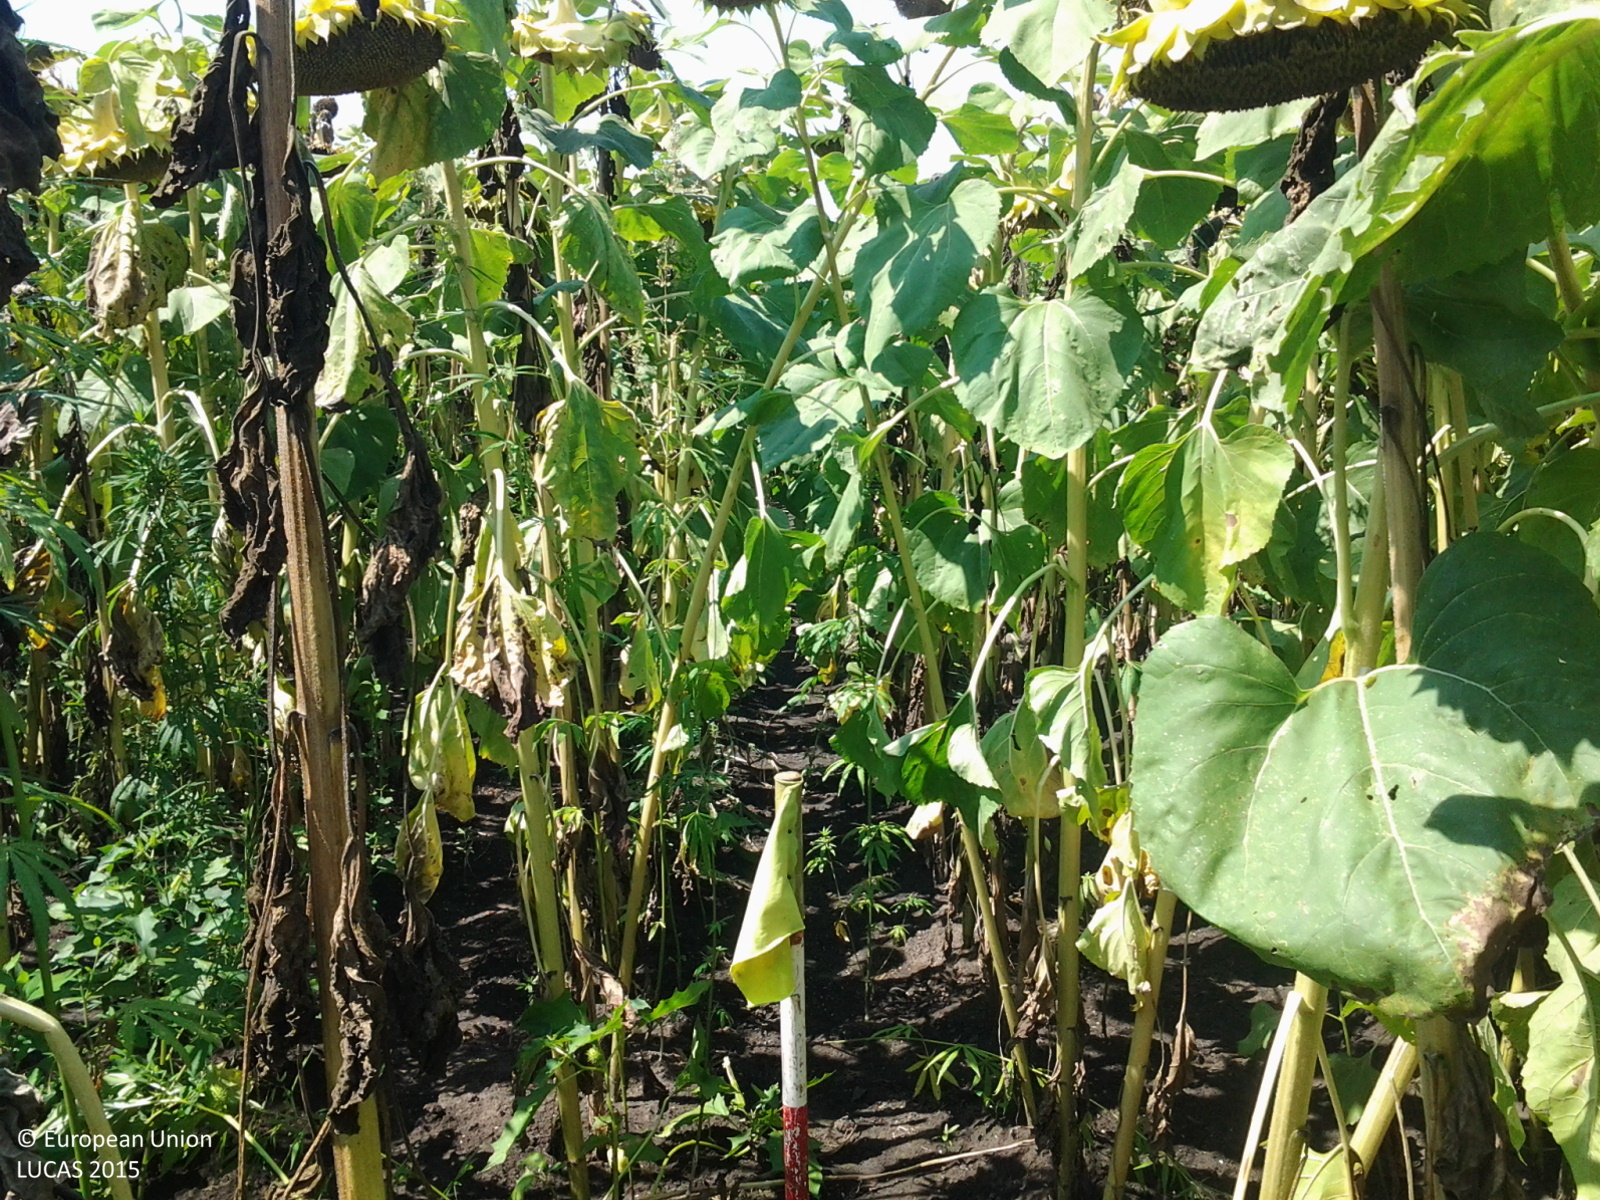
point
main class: Cropland
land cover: Sunflower
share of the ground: > 75 %
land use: Agriculture (excluding fallow land and kitchen gardens)
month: August
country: HU
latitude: 47.2386
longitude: 19.8384
